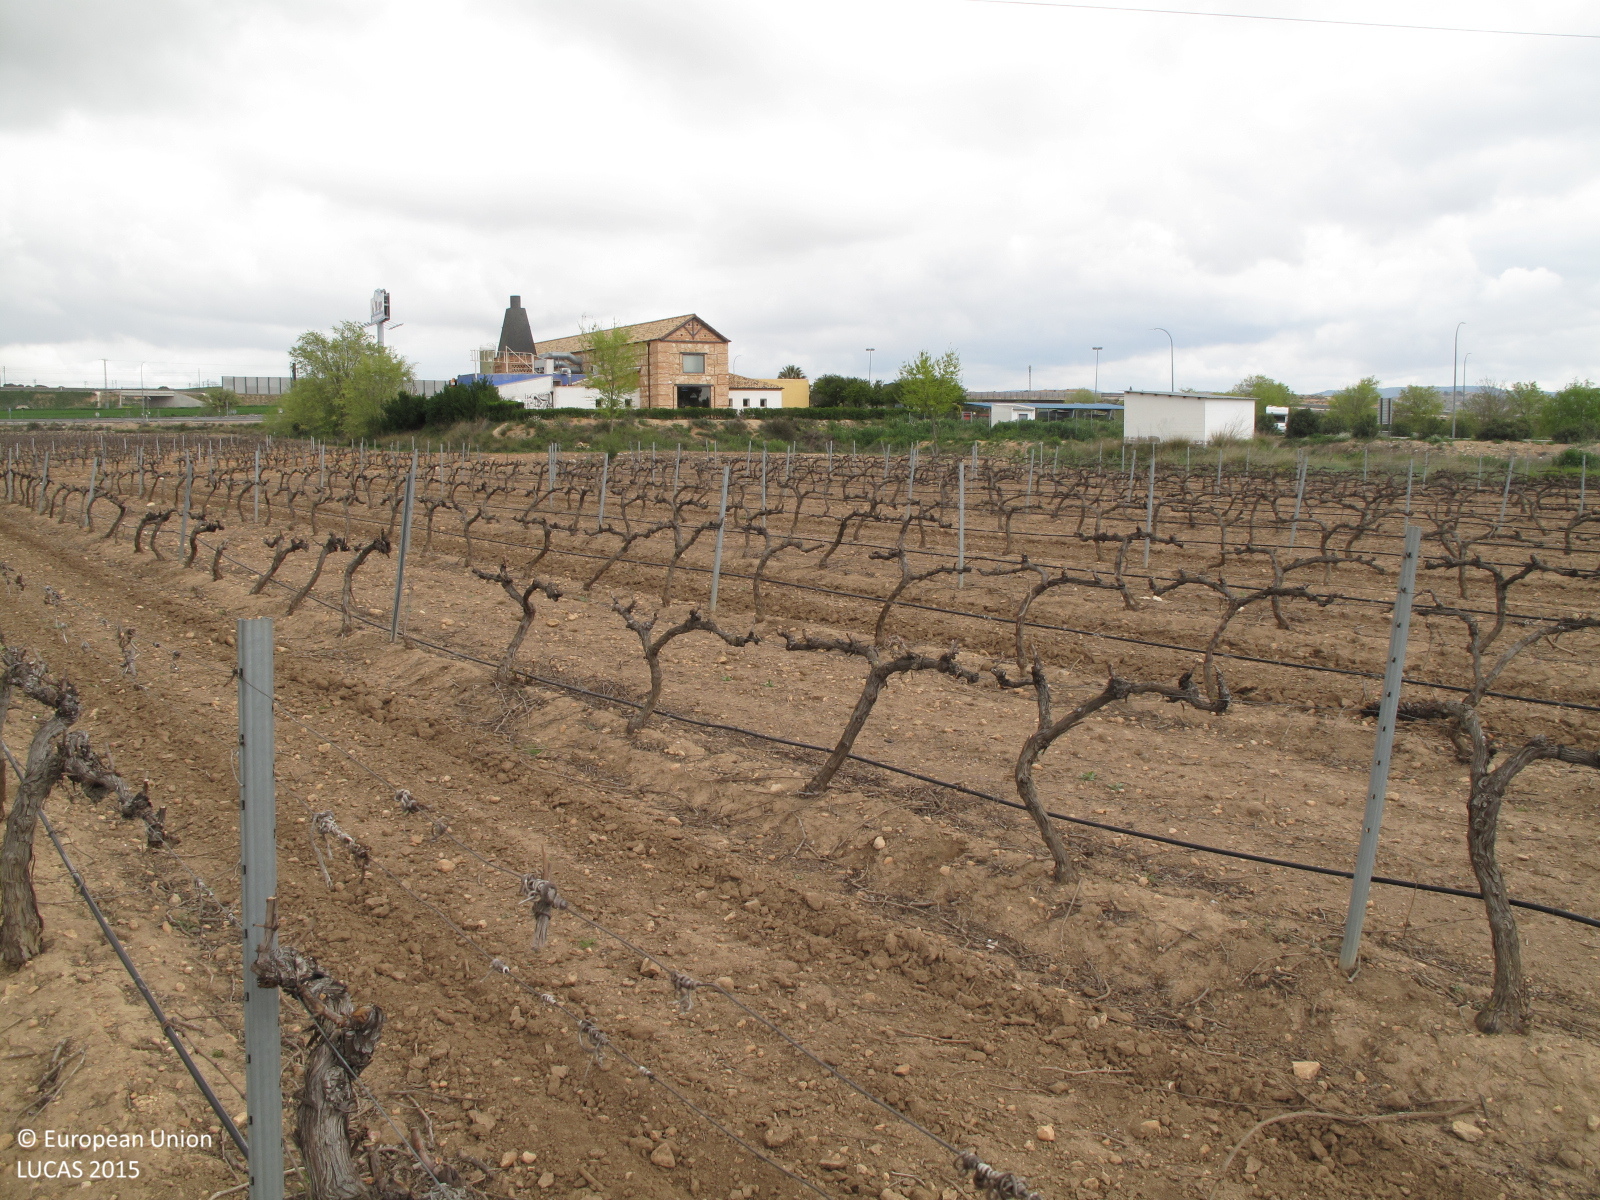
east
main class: Cropland
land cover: Vineyards
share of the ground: < 10 %
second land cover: Other bare soil
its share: > 75 %
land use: Agriculture (excluding fallow land and kitchen gardens)
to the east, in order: Vineyards; Other bare soil; Electric lines; Other bare soil; Spontaneously vegetated surfaces; Tracks; Spontaneously vegetated surfaces; Managed hedges; Artificial constructions in urban areas; Groves; Artificial constructions in urban areas; Lines of trees; Paved roads, cycling and walking lanes; Spontaneously vegetated surfaces; Fences; Spontaneously vegetated surfaces
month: April
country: ES
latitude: 38.7571
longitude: -0.9587
